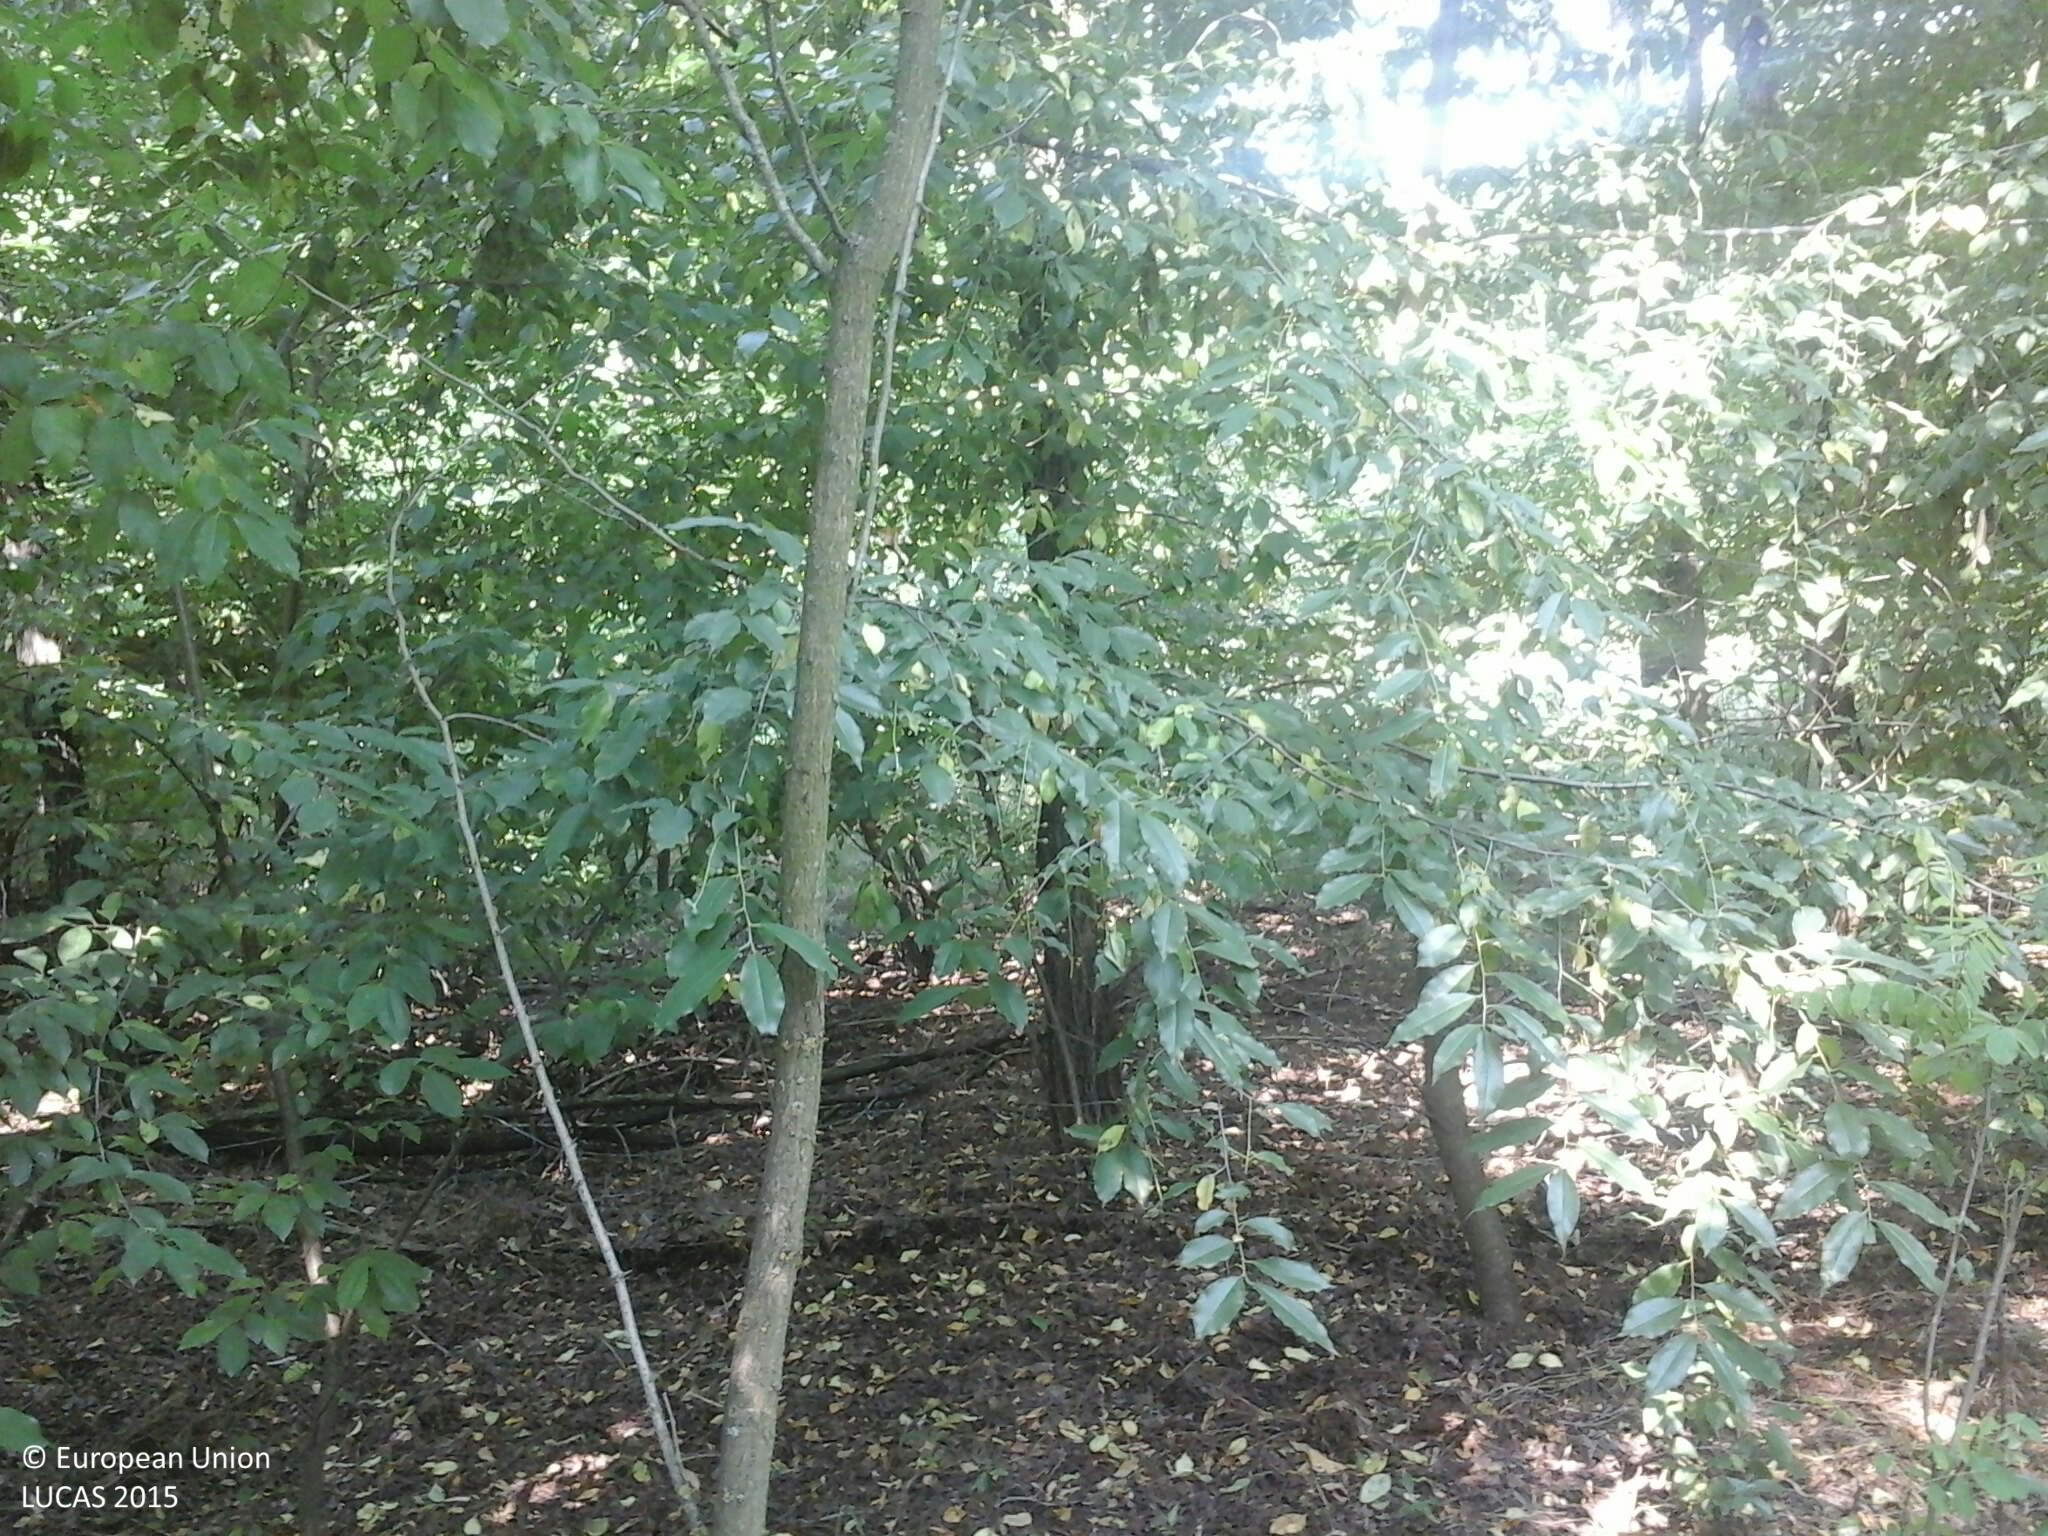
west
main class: Woodland
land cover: Broadleaved woodland
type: mesophytic deciduous forest
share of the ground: 25 - 50 %
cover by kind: broadleaved forest trees 95 %, herbaceous plants 5 %
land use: Forestry
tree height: > 5 m
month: July
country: HU
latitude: 47.6892
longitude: 21.8662
